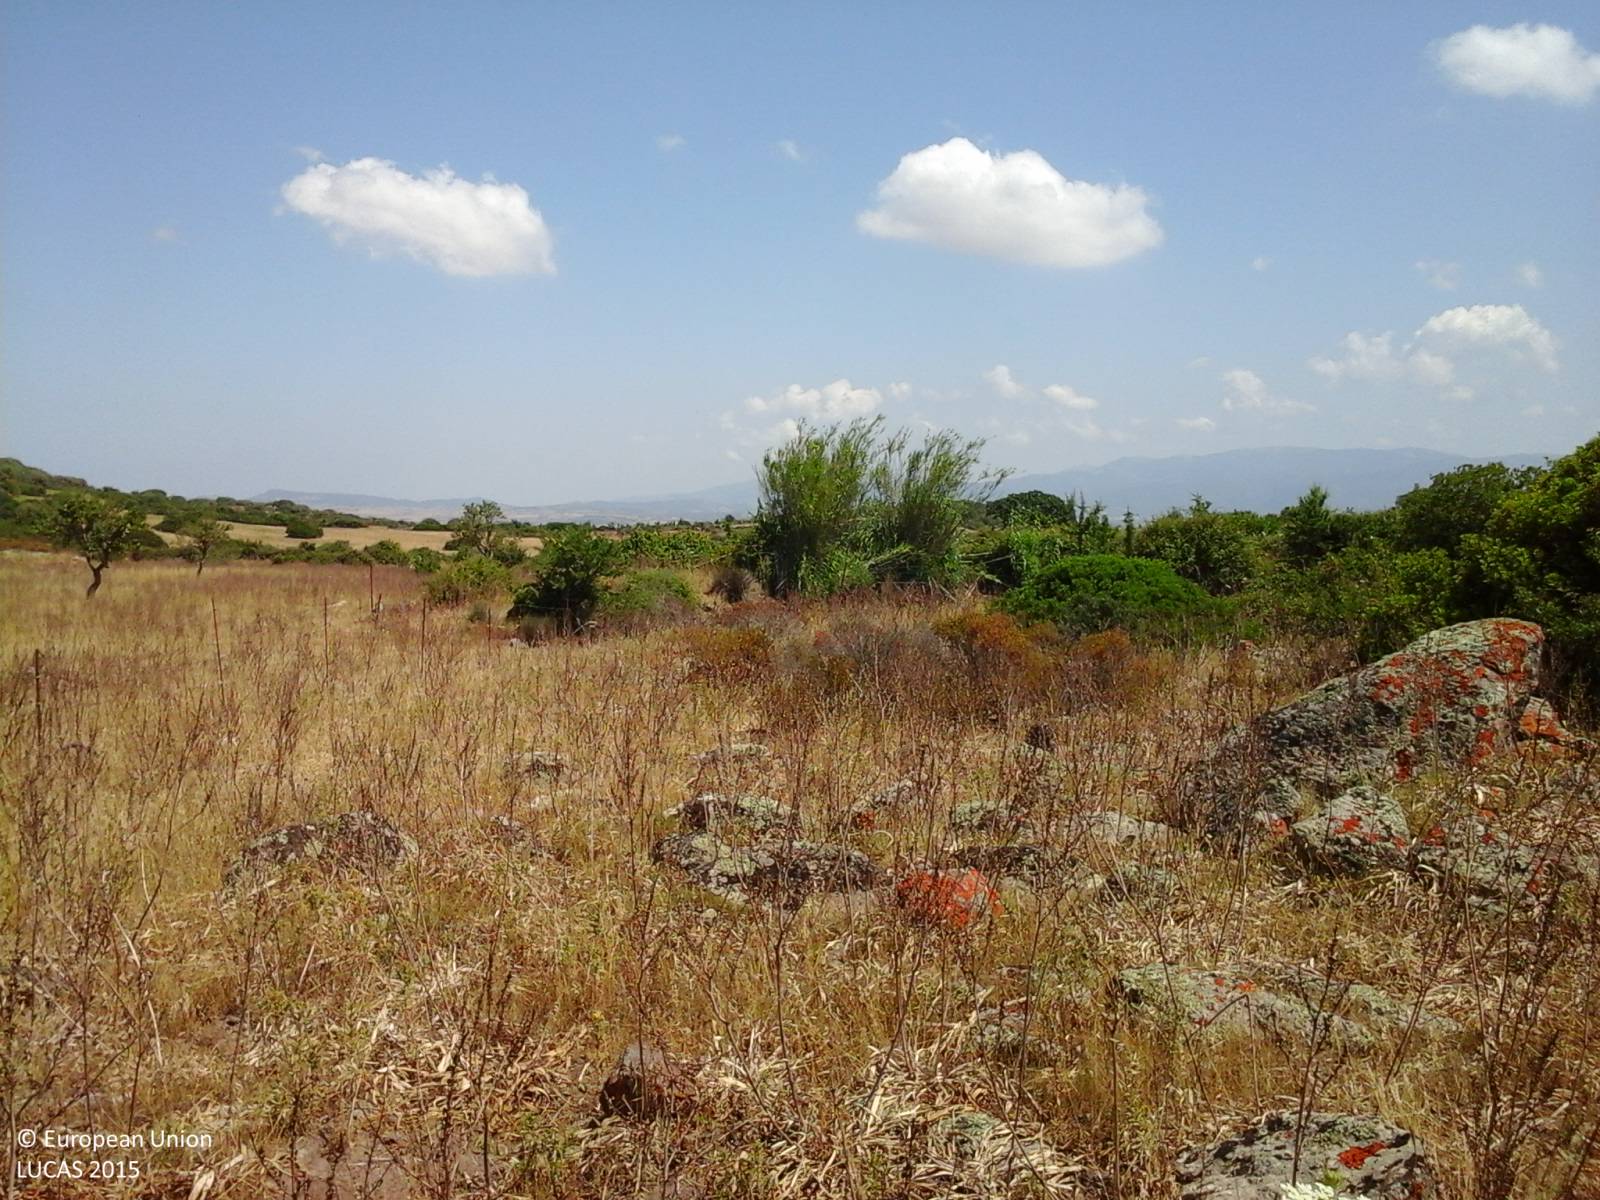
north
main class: Grassland
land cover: Grassland without tree/shrub cover
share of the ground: > 75 %
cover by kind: herbaceous plants 95 %, shrubs 5 %
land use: Agriculture (excluding fallow land and kitchen gardens)
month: June
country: IT
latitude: 40.7494
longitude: 8.8567
